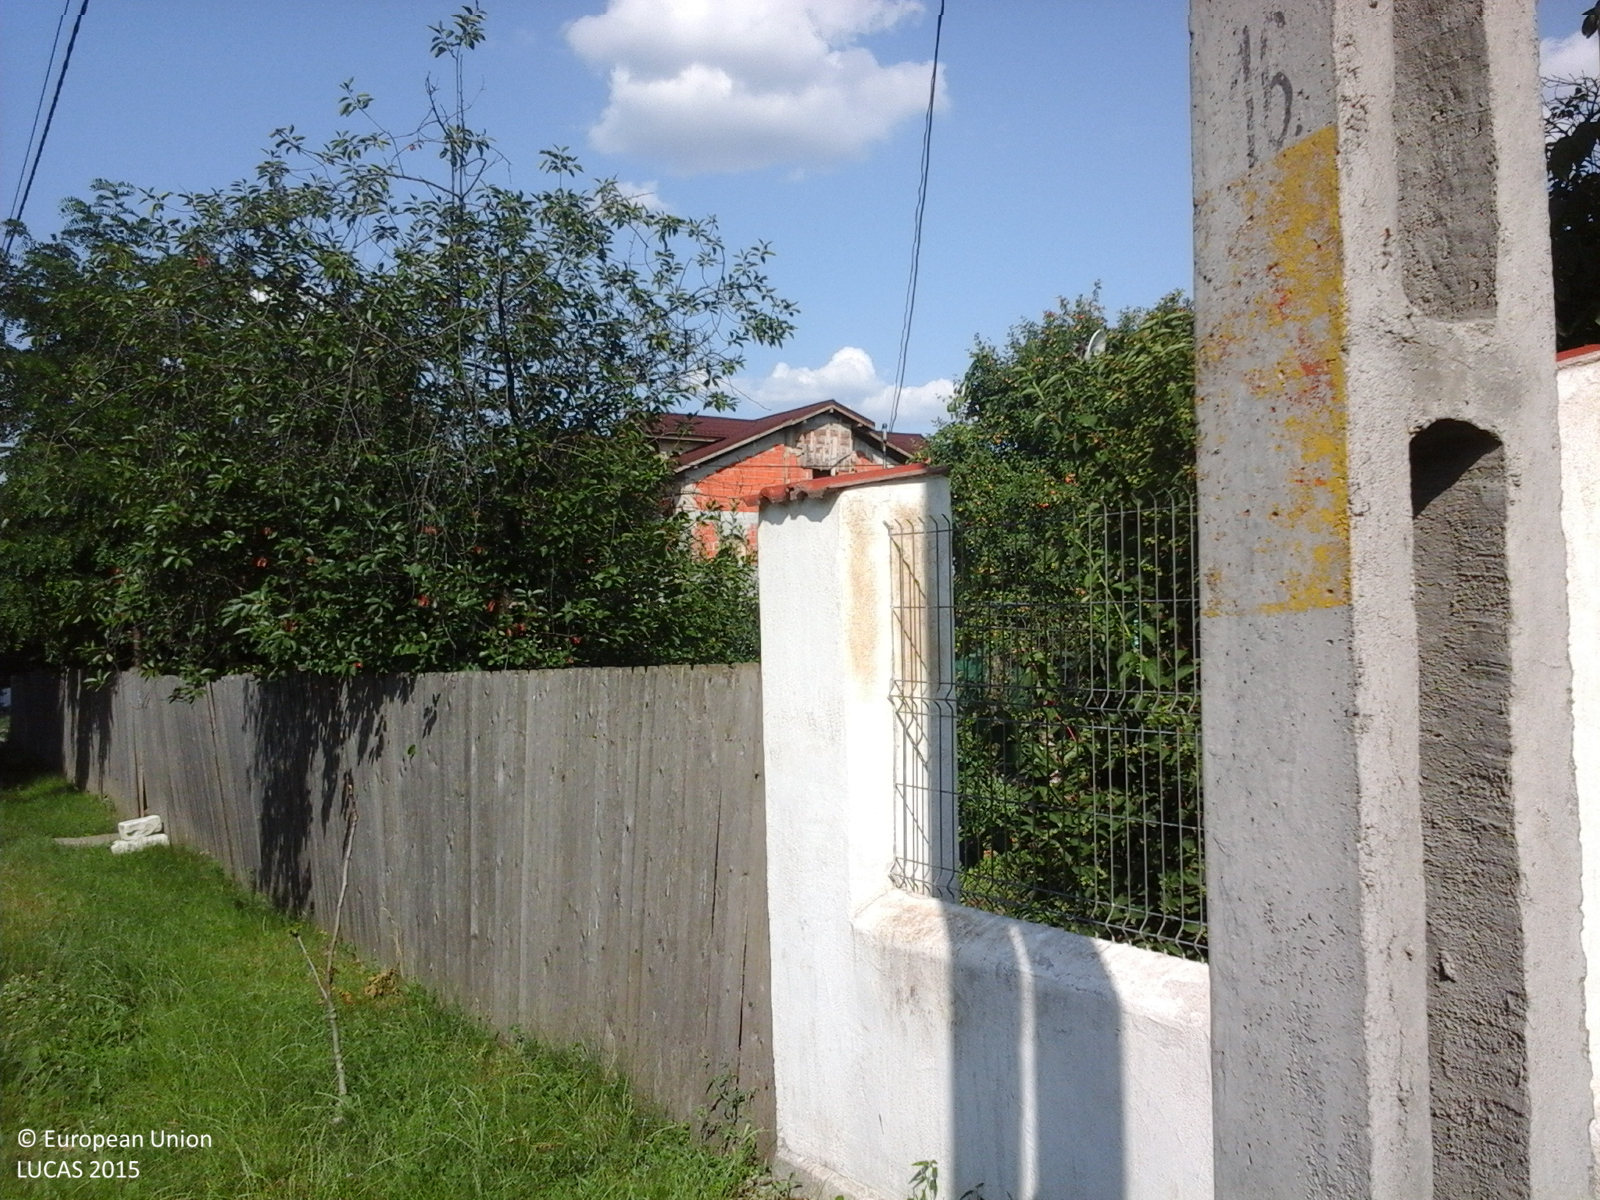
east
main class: Cropland
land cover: Apple fruit
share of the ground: 50 - 75 %
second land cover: Grassland without tree/shrub cover
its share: > 75 %
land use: Agriculture (excluding fallow land and kitchen gardens)
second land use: Residential
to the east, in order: Apple fruit; Grassland without tree/shrub cover; Artificial constructions in urban areas; Apple fruit; Fences; Grass margins; Common wheat; Oats; Maize; Grass margins; Lucerne
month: June
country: RO
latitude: 44.6061
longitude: 26.2251
